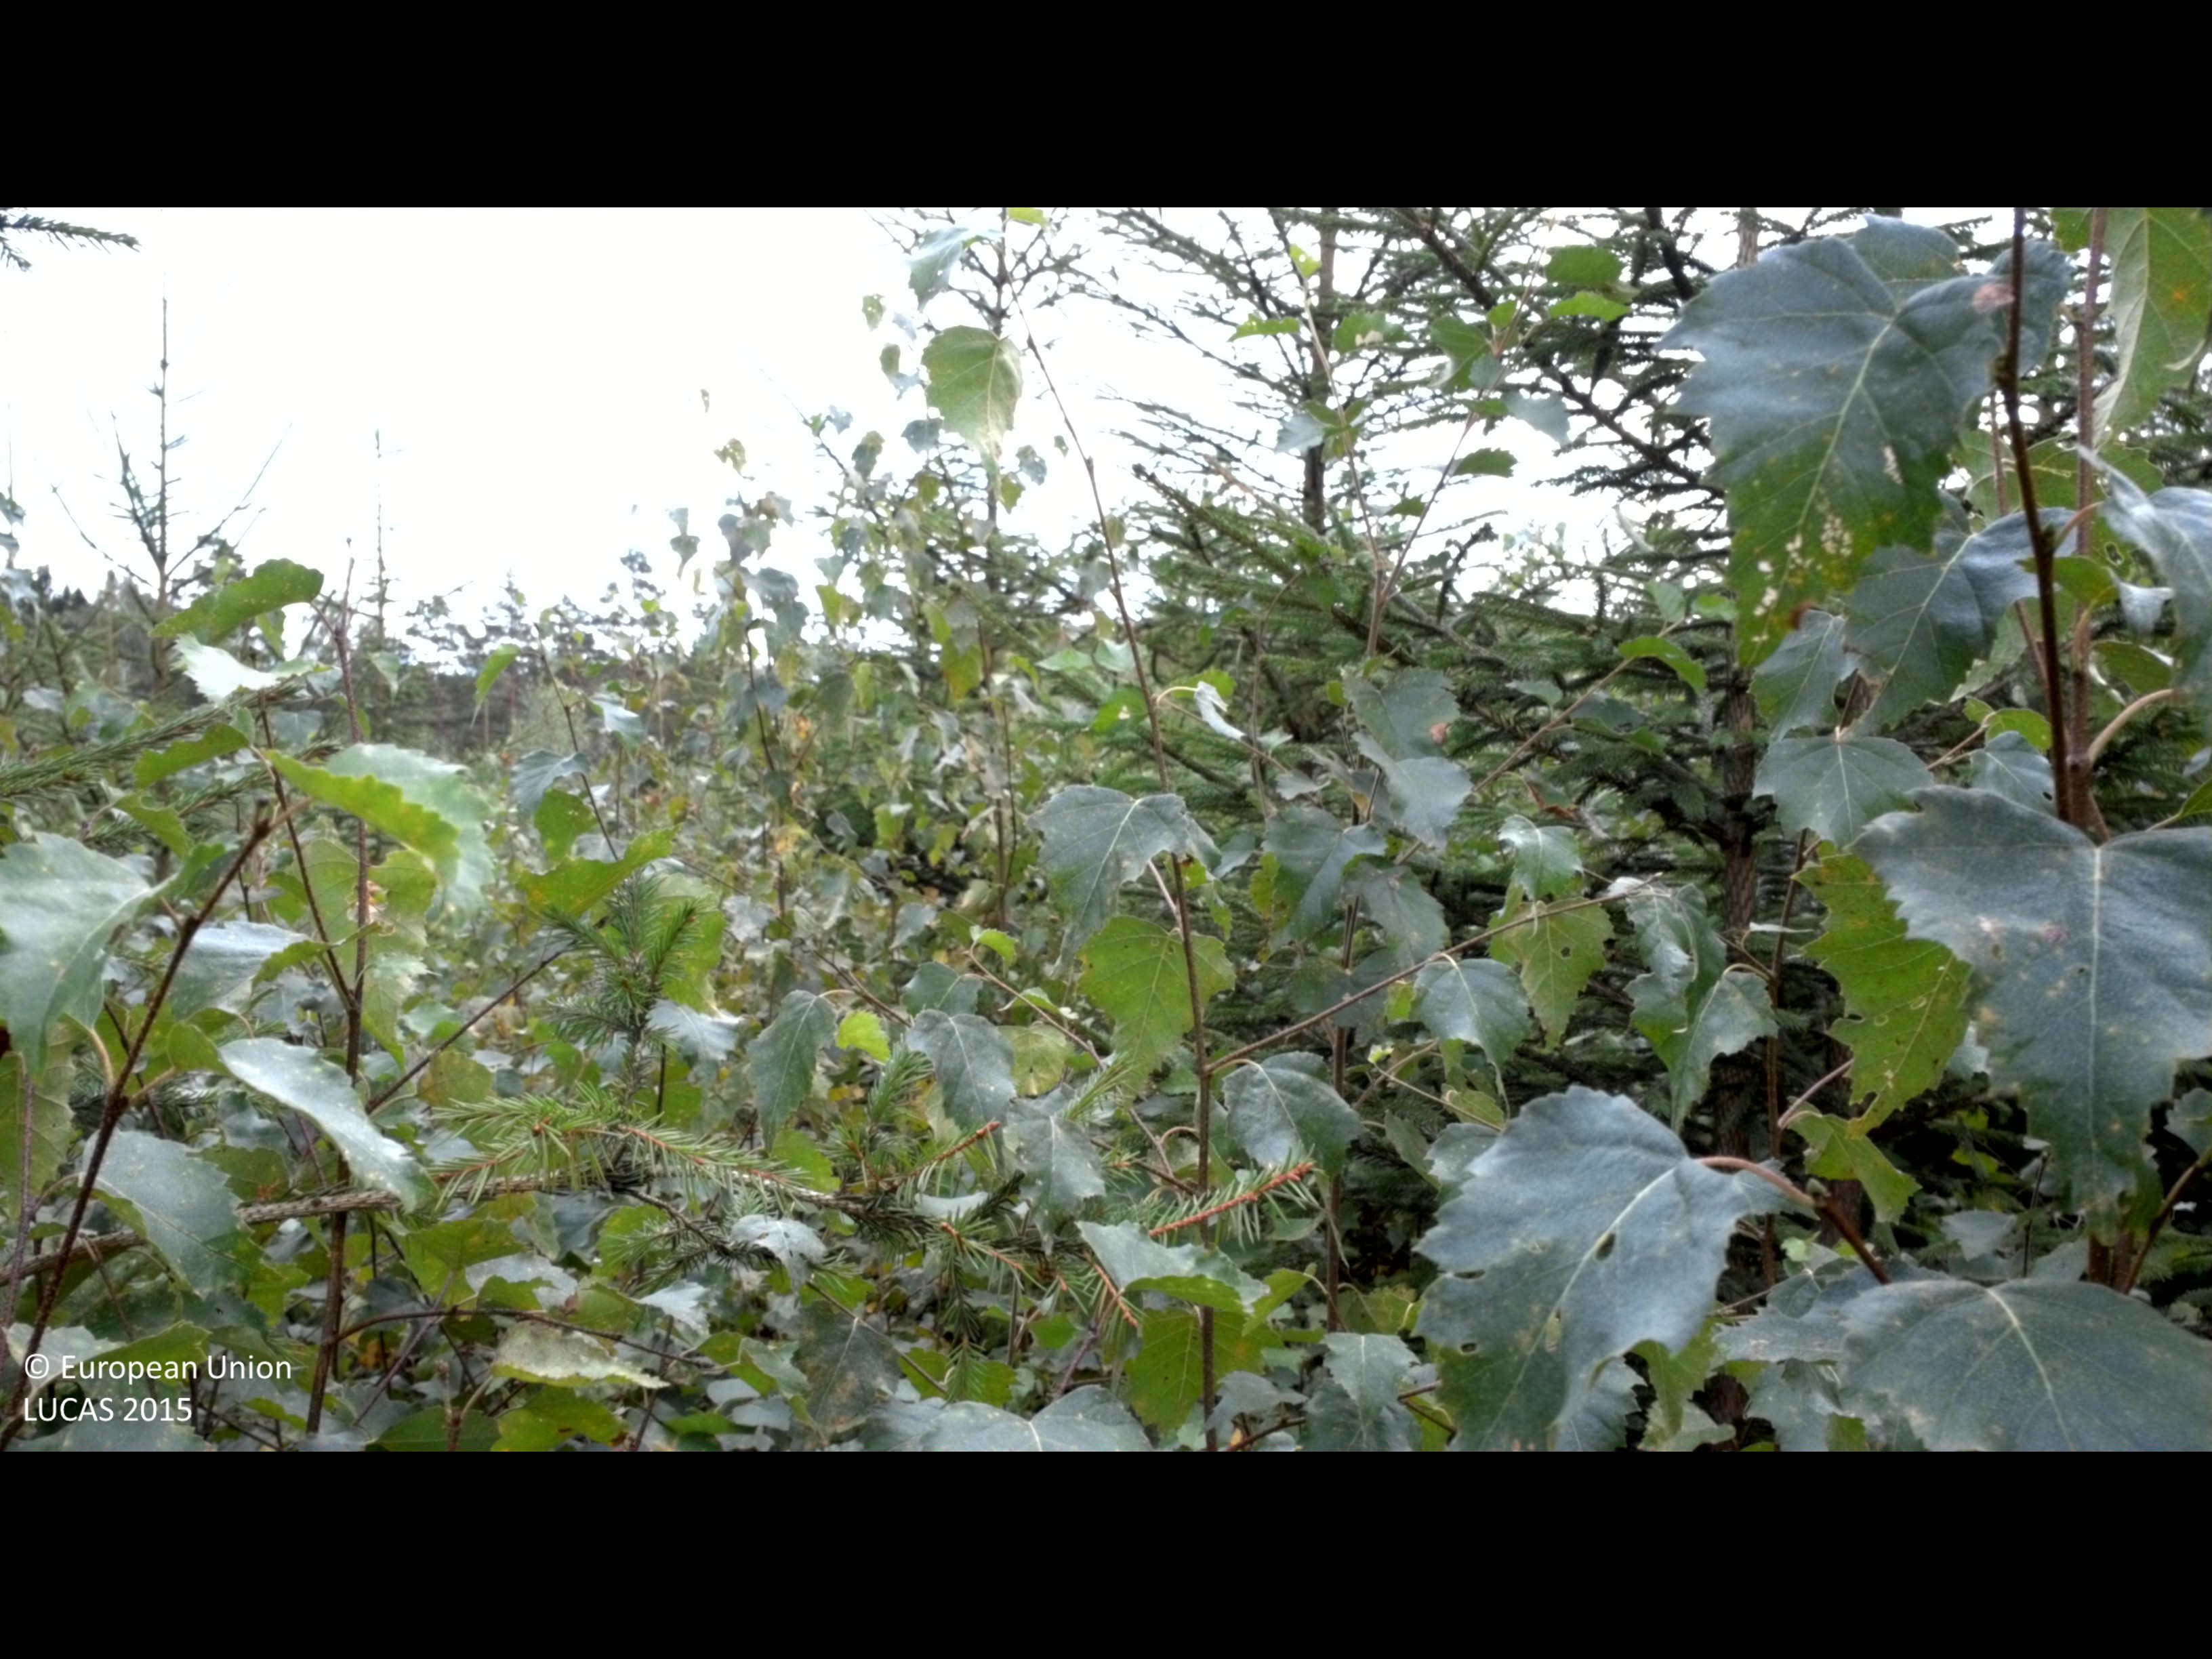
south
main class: Woodland
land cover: Spruce dominated mixed woodland
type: boreal forest
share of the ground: > 75 %
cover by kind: broadleaved forest trees 55 %, coniferous forest trees 35 %, shrubs 5 %, herbaceous plants 5 %
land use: Forestry
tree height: < 5 m
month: September
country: SE
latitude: 56.7616
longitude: 13.1211
